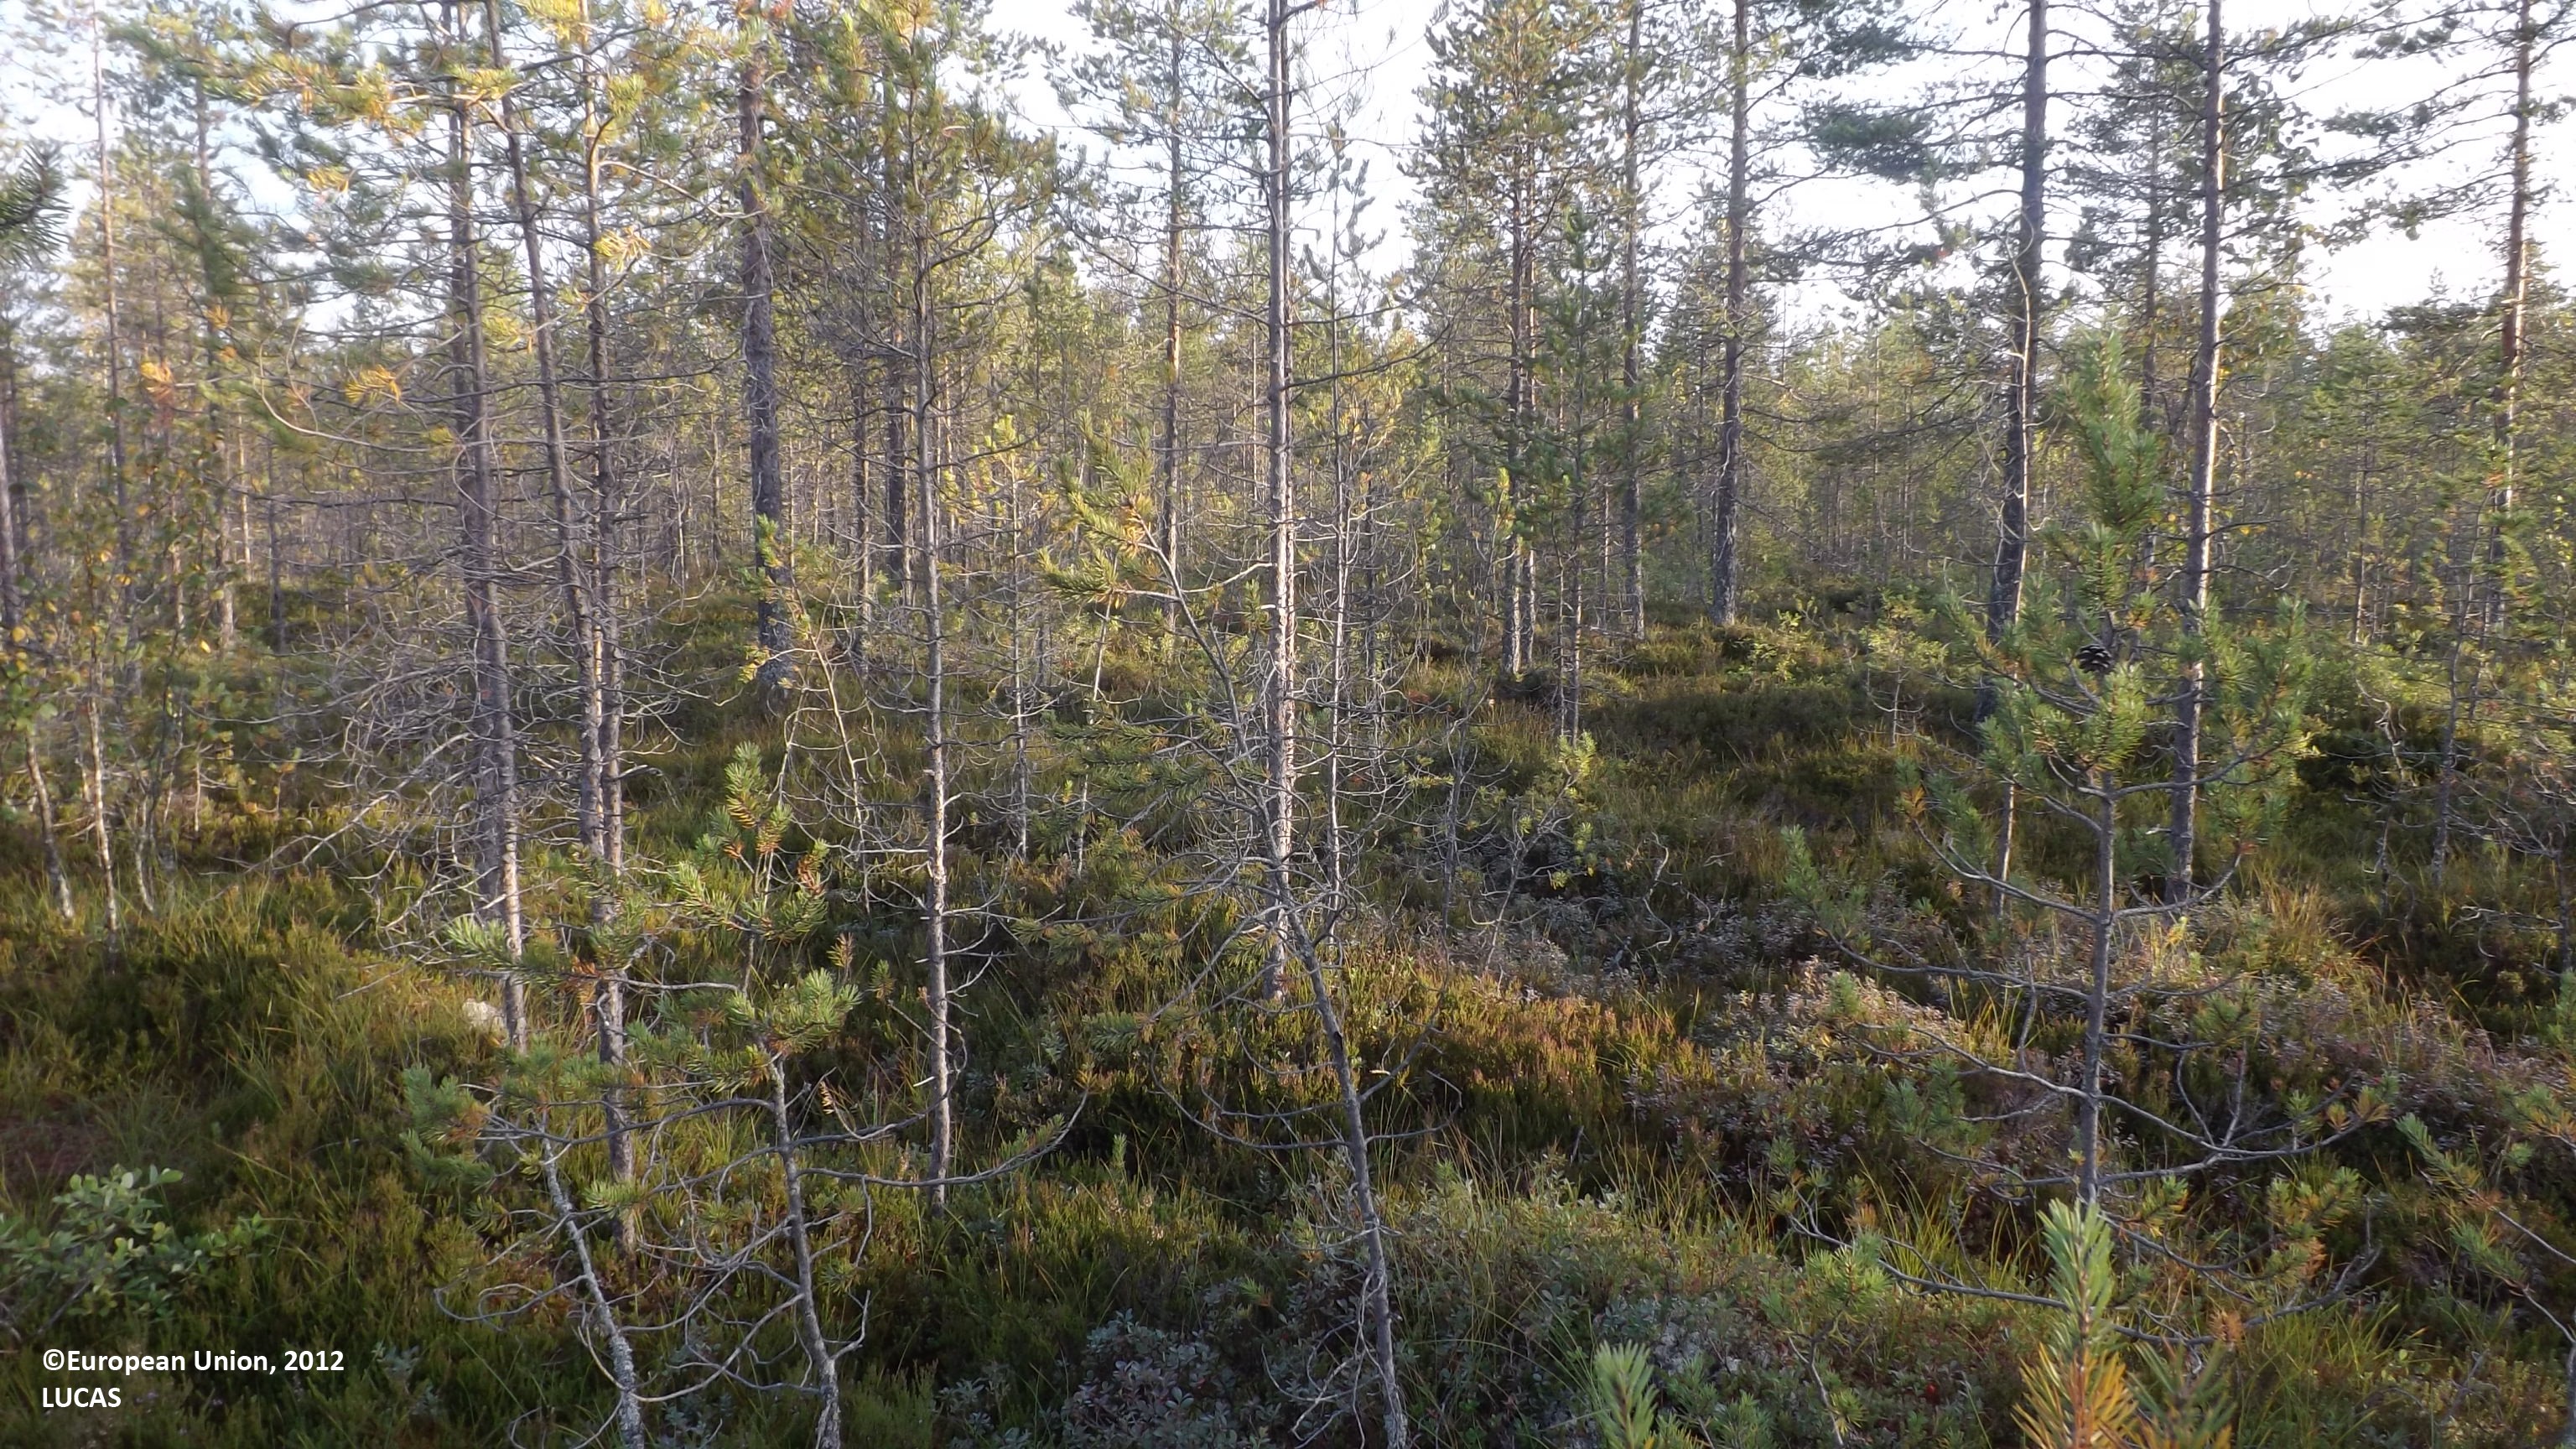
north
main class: Woodland
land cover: Pine dominated coniferous woodland
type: mire and swamp forests
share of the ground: 10 - 25 %
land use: Forestry
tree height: < 5 m
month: August
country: FI
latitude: 63.8015
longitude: 24.0979
